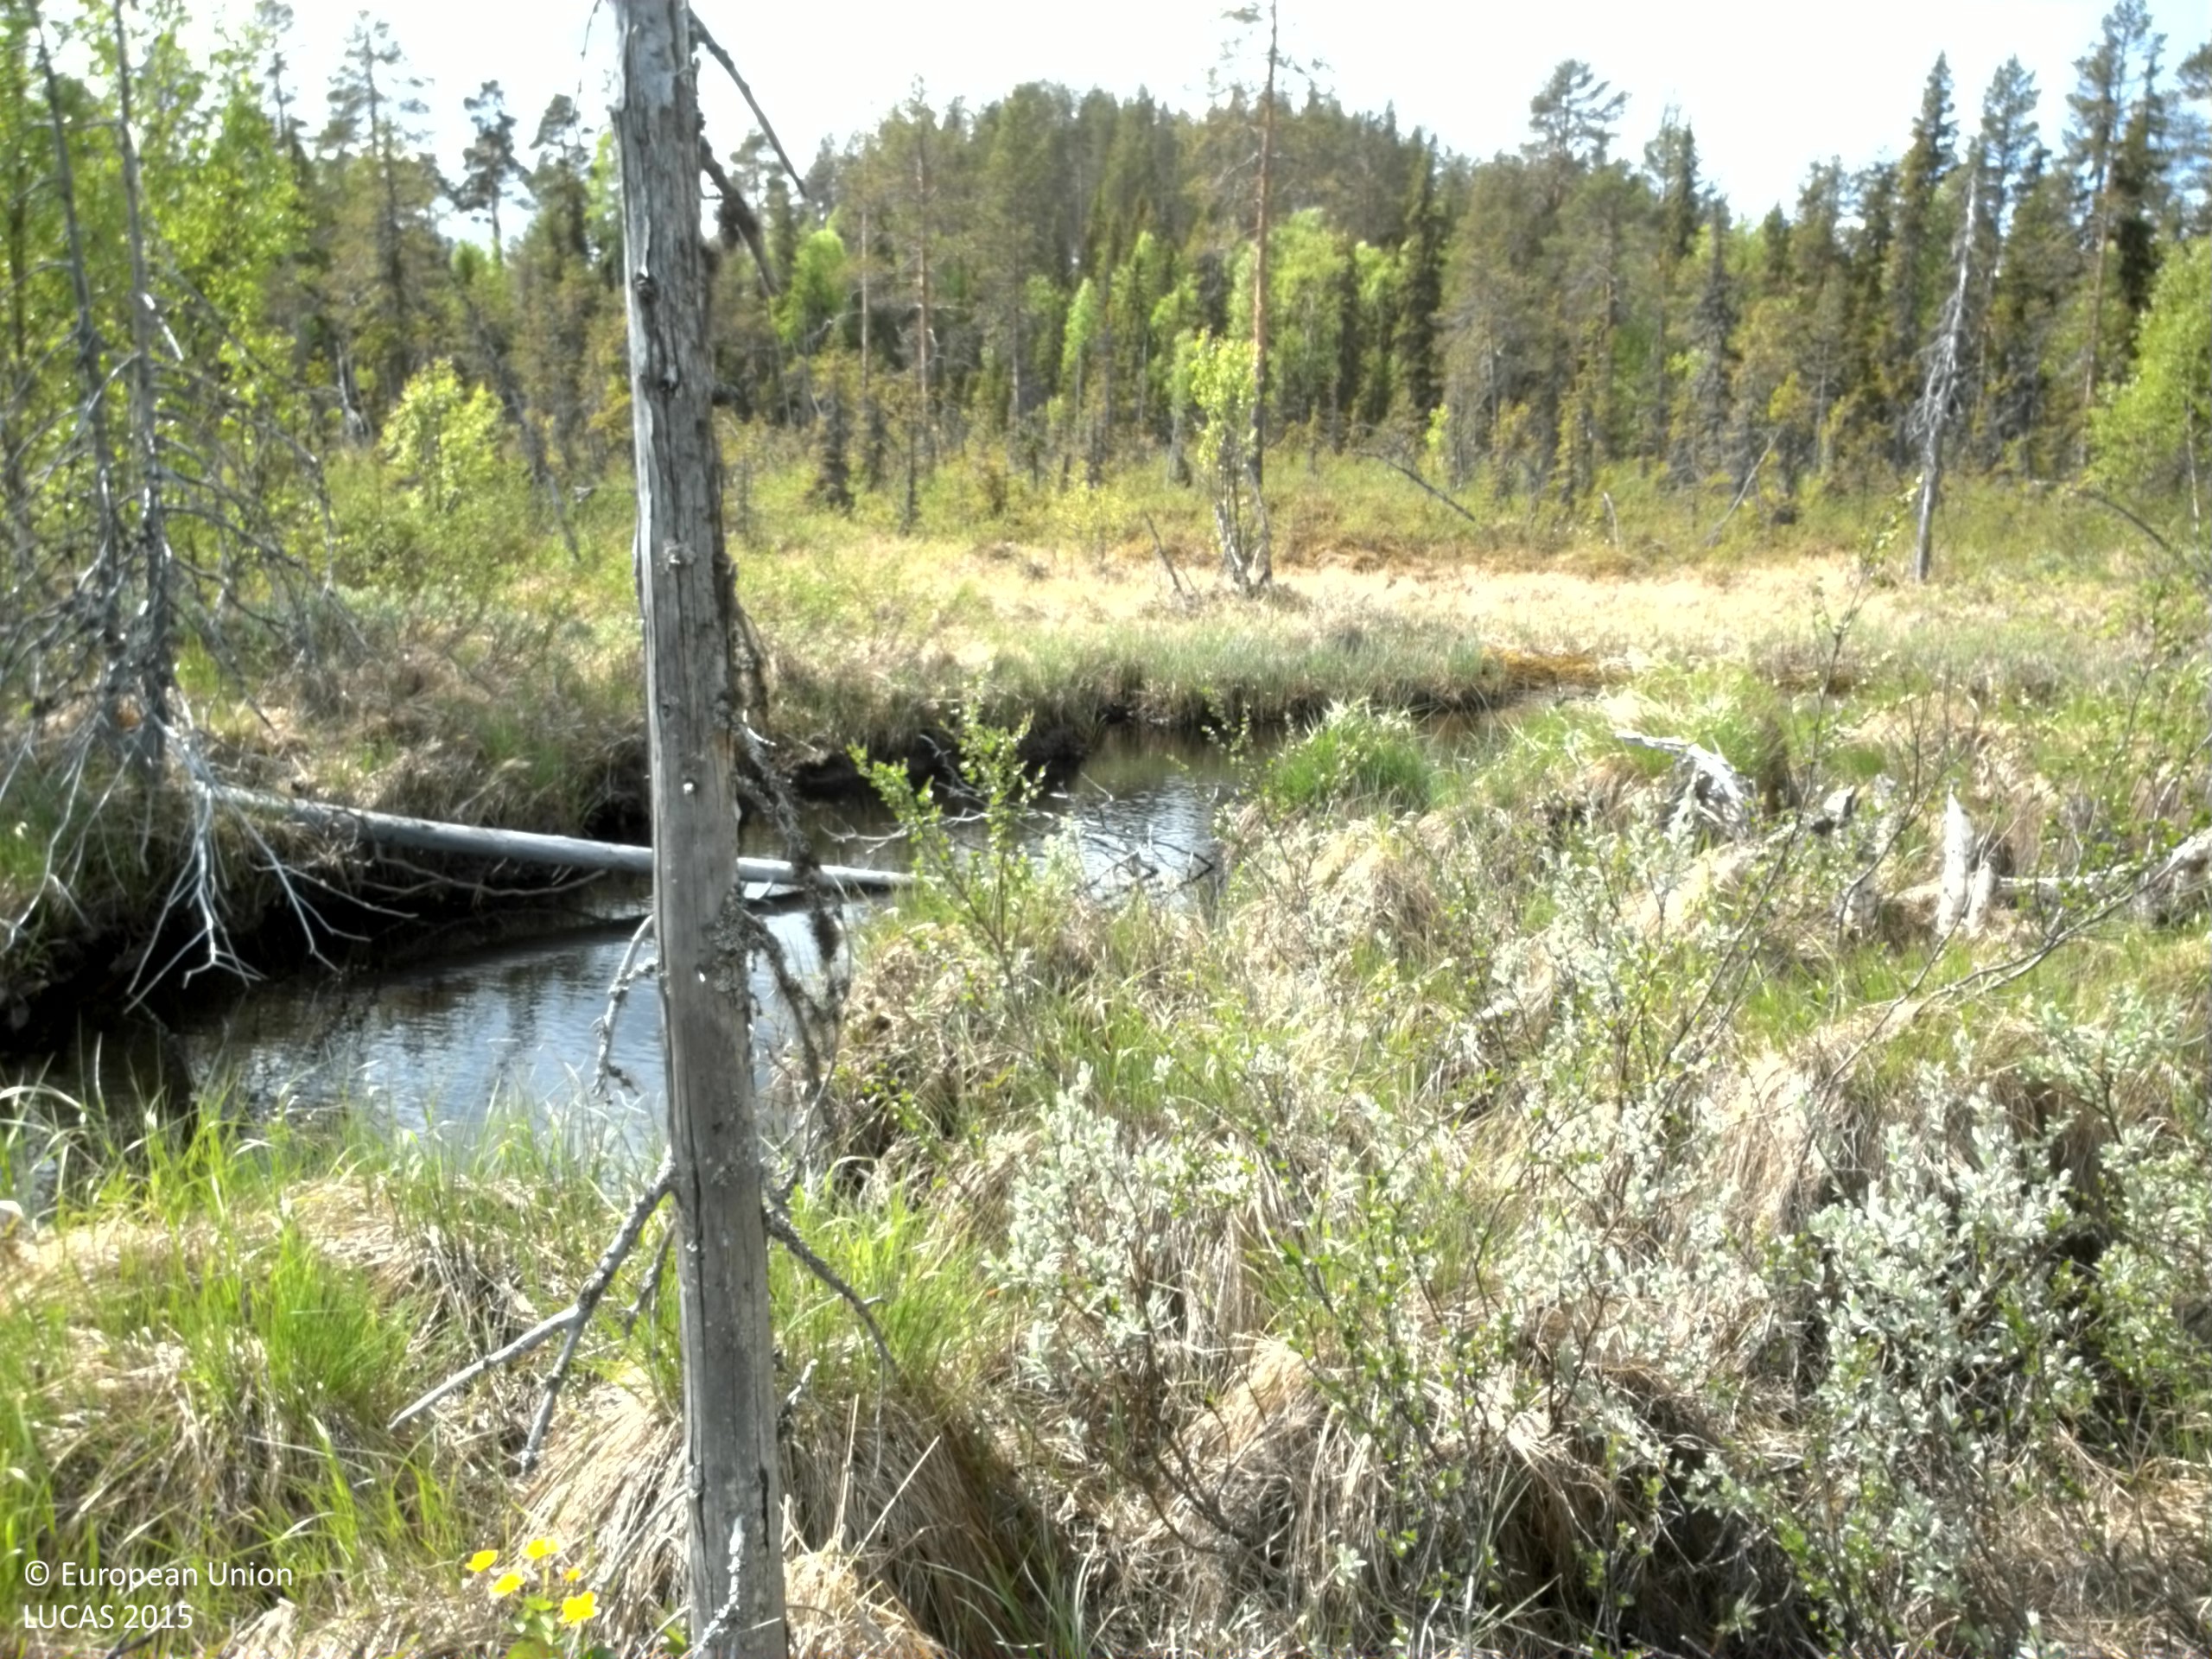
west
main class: Woodland
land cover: Pine dominated coniferous woodland
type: boreal forest
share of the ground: 25 - 50 %
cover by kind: coniferous forest trees 50 %, shrubs 30 %, herbaceous plants 20 %
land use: Forestry
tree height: > 5 m
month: June
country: SE
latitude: 63.2024
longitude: 17.9092
